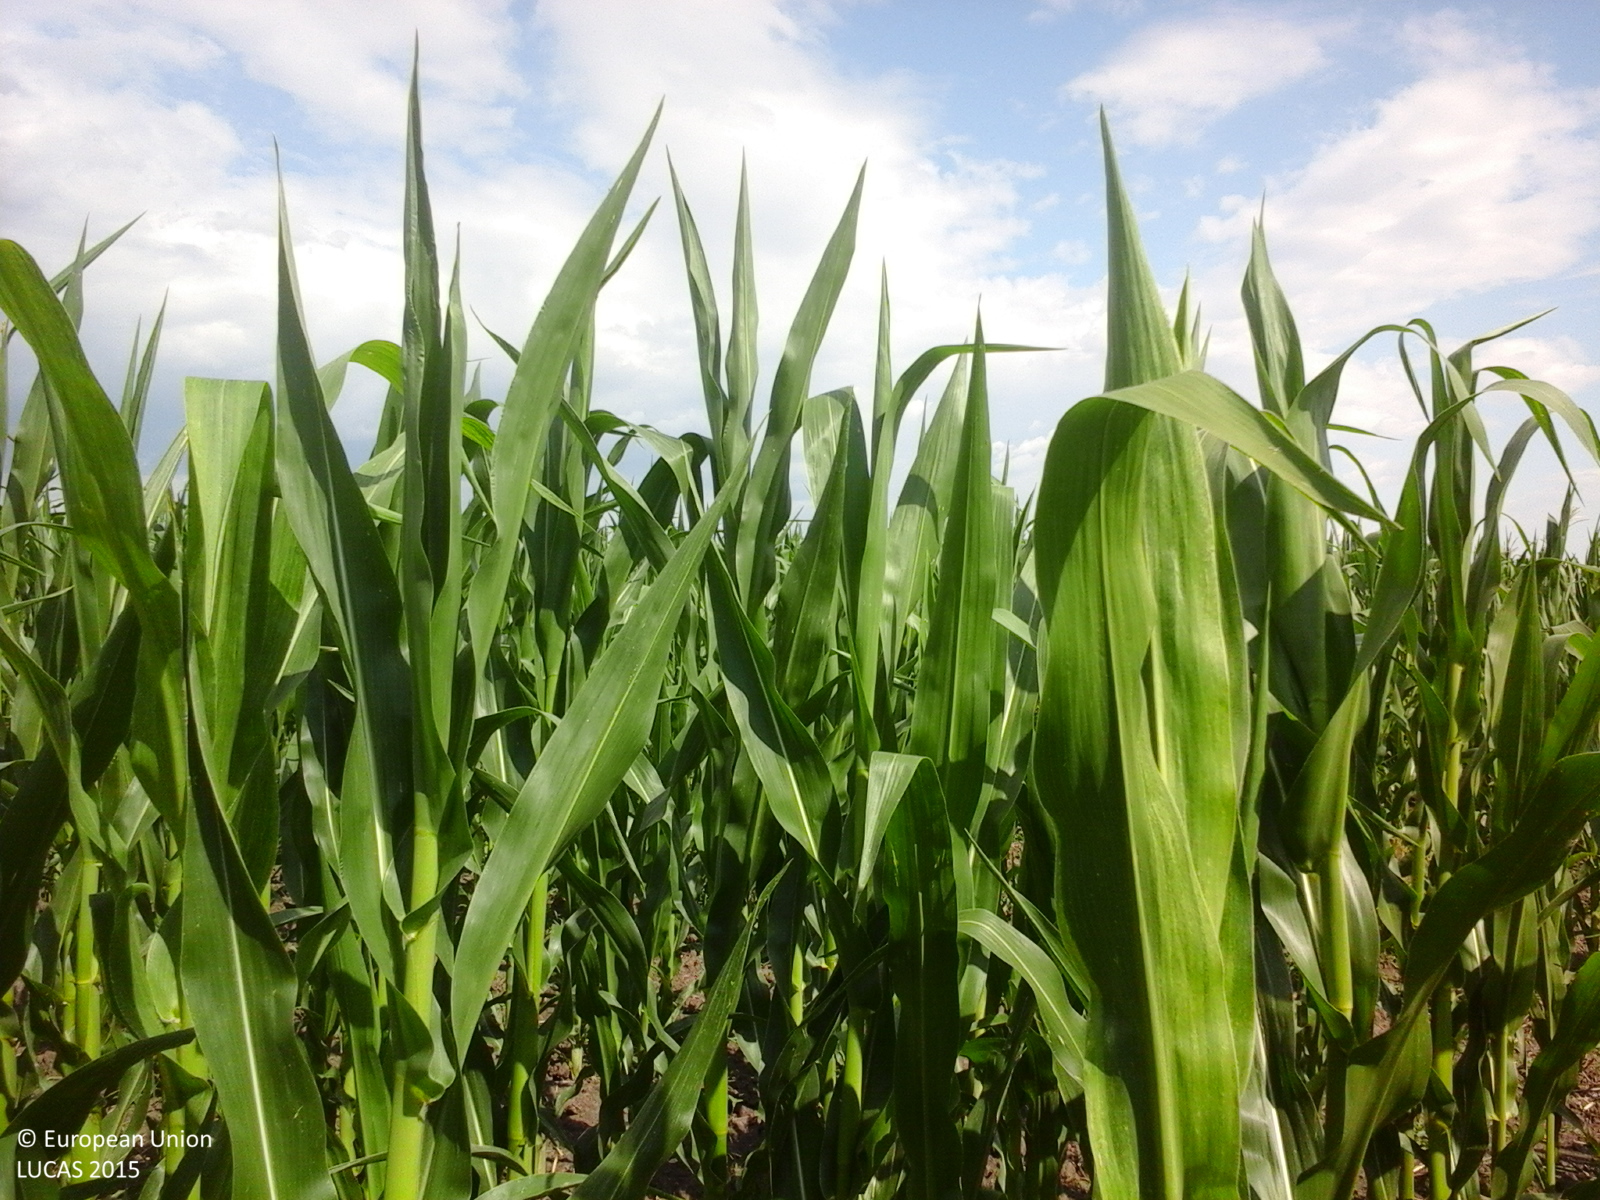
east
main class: Cropland
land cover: Maize
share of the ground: > 75 %
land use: Agriculture (excluding fallow land and kitchen gardens)
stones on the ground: < 10 %
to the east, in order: Maize; Spontaneously vegetated surfaces
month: July
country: RO
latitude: 44.3369
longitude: 25.3506
